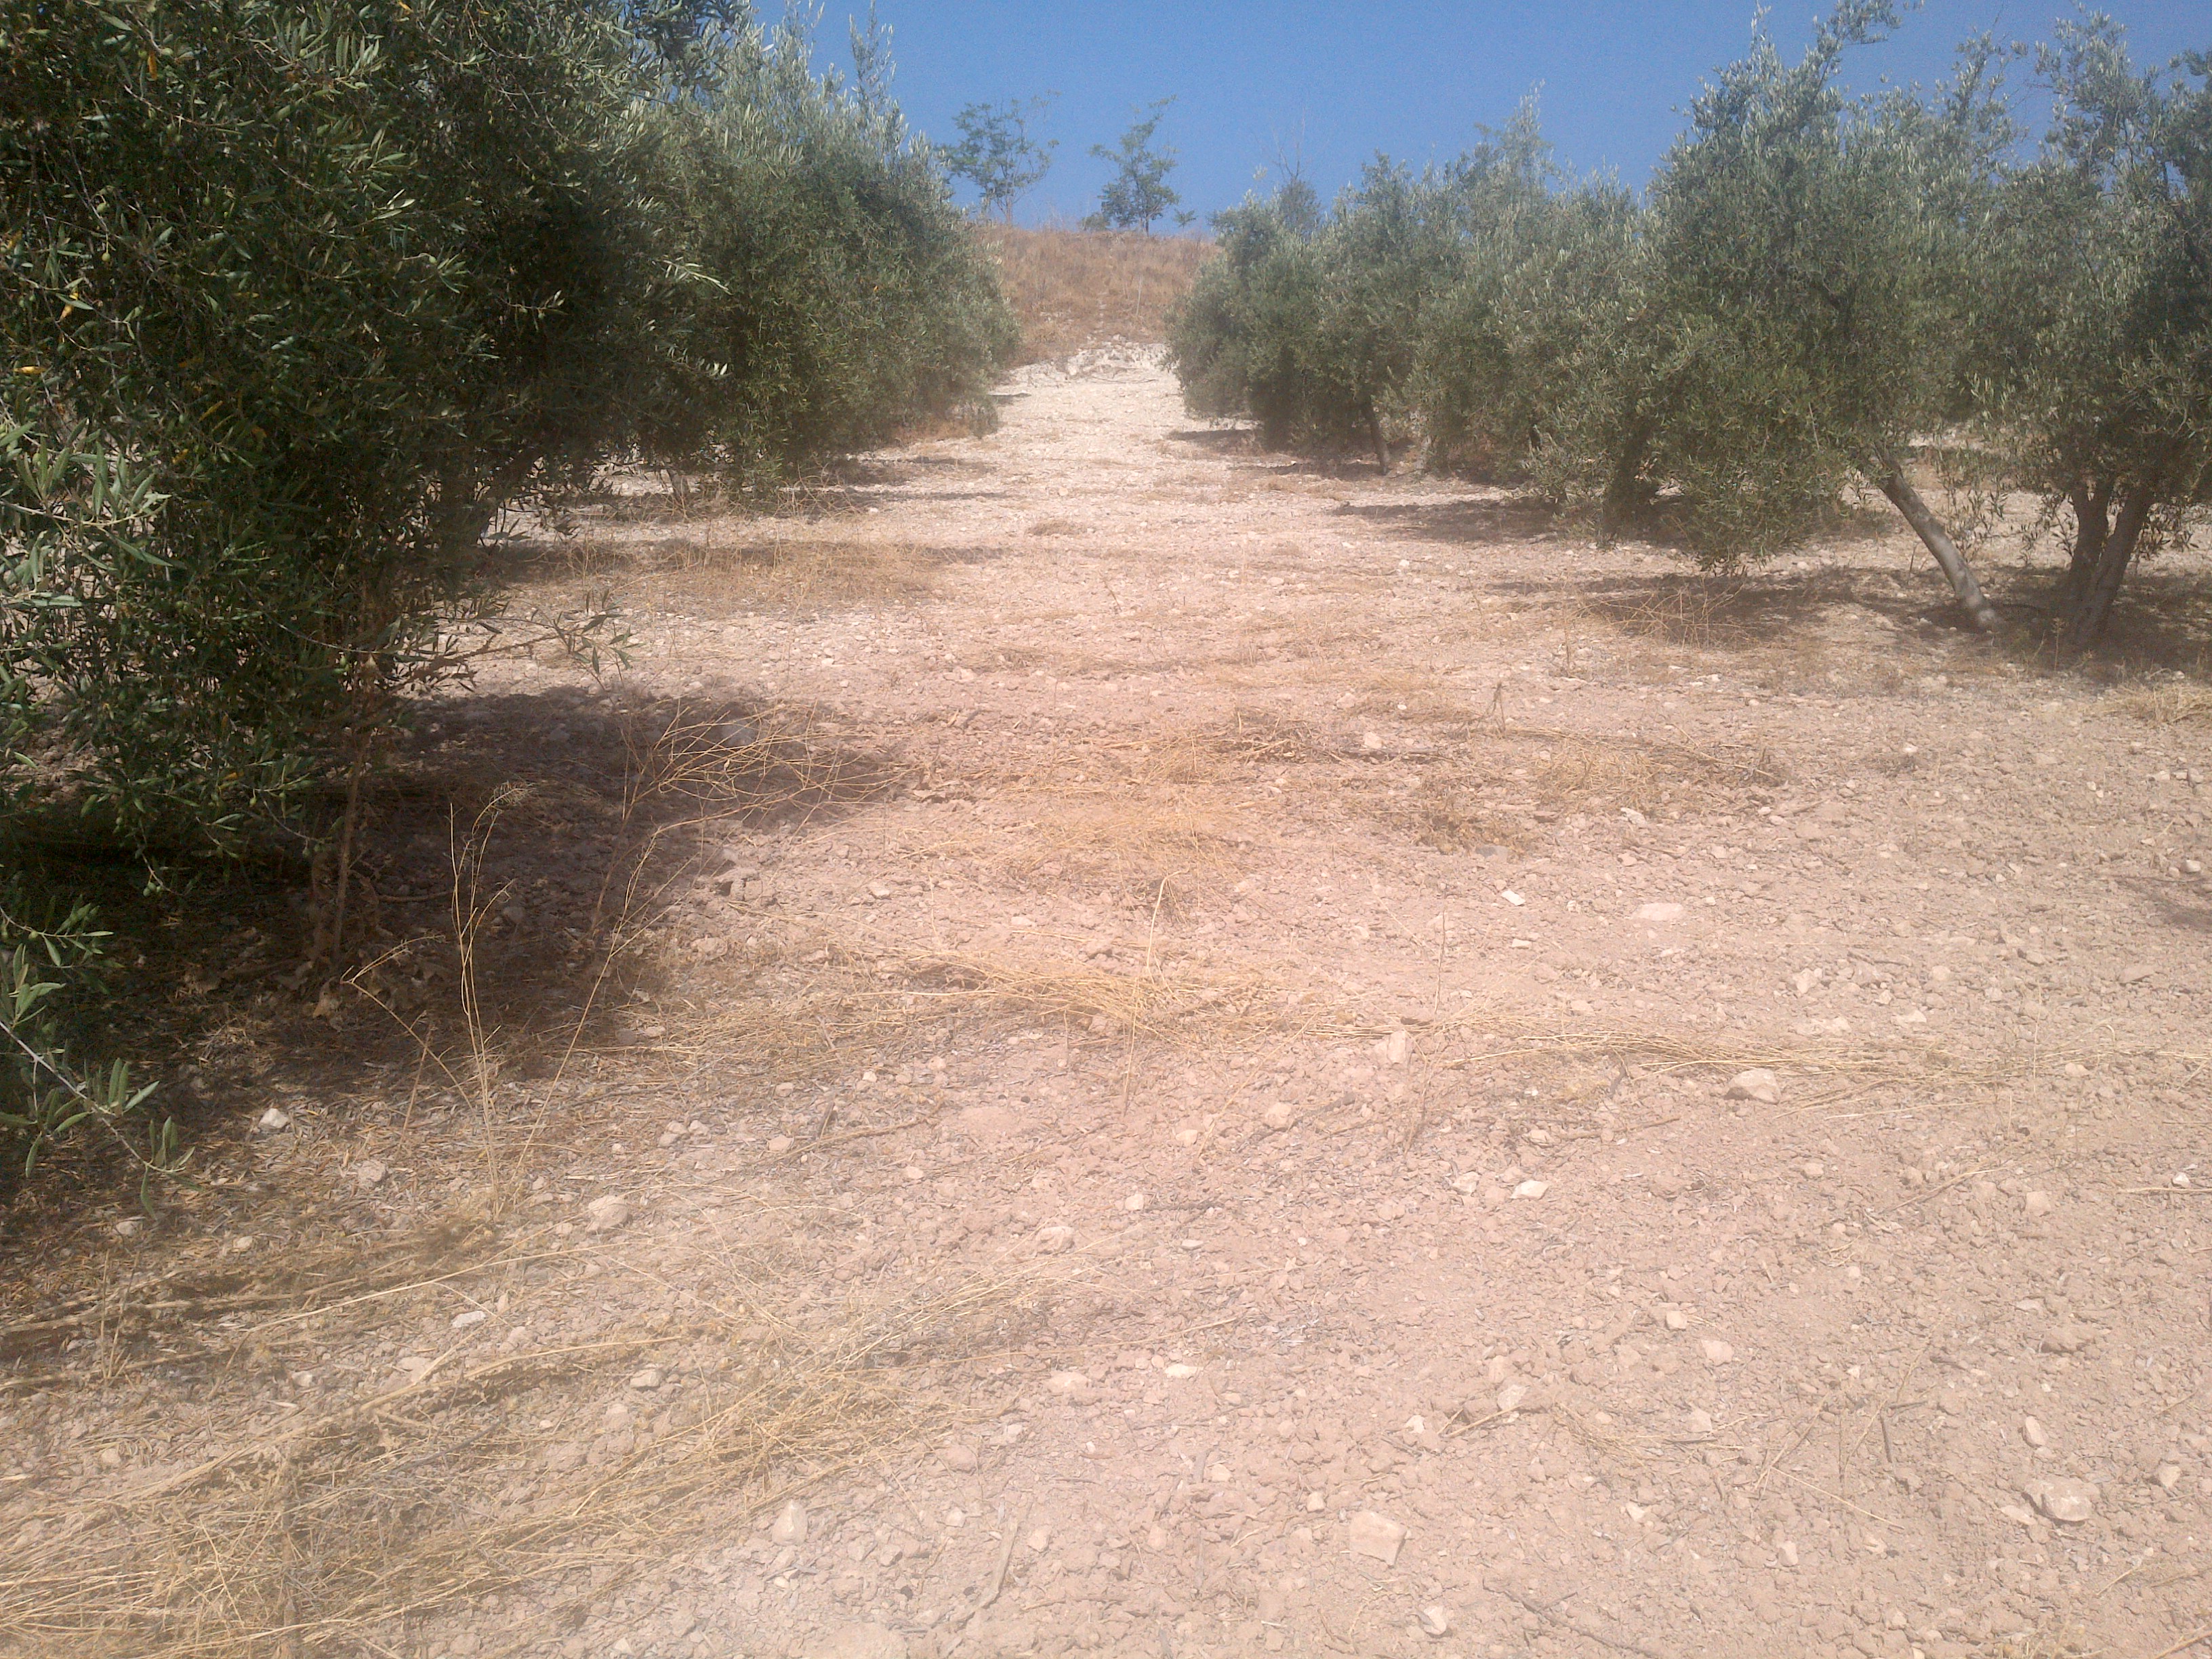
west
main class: Cropland
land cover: Olive groves
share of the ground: 50 - 75 %
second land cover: Other bare soil
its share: > 75 %
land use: Agriculture (excluding fallow land and kitchen gardens)
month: June
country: ES
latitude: 37.6782
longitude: -4.2569
